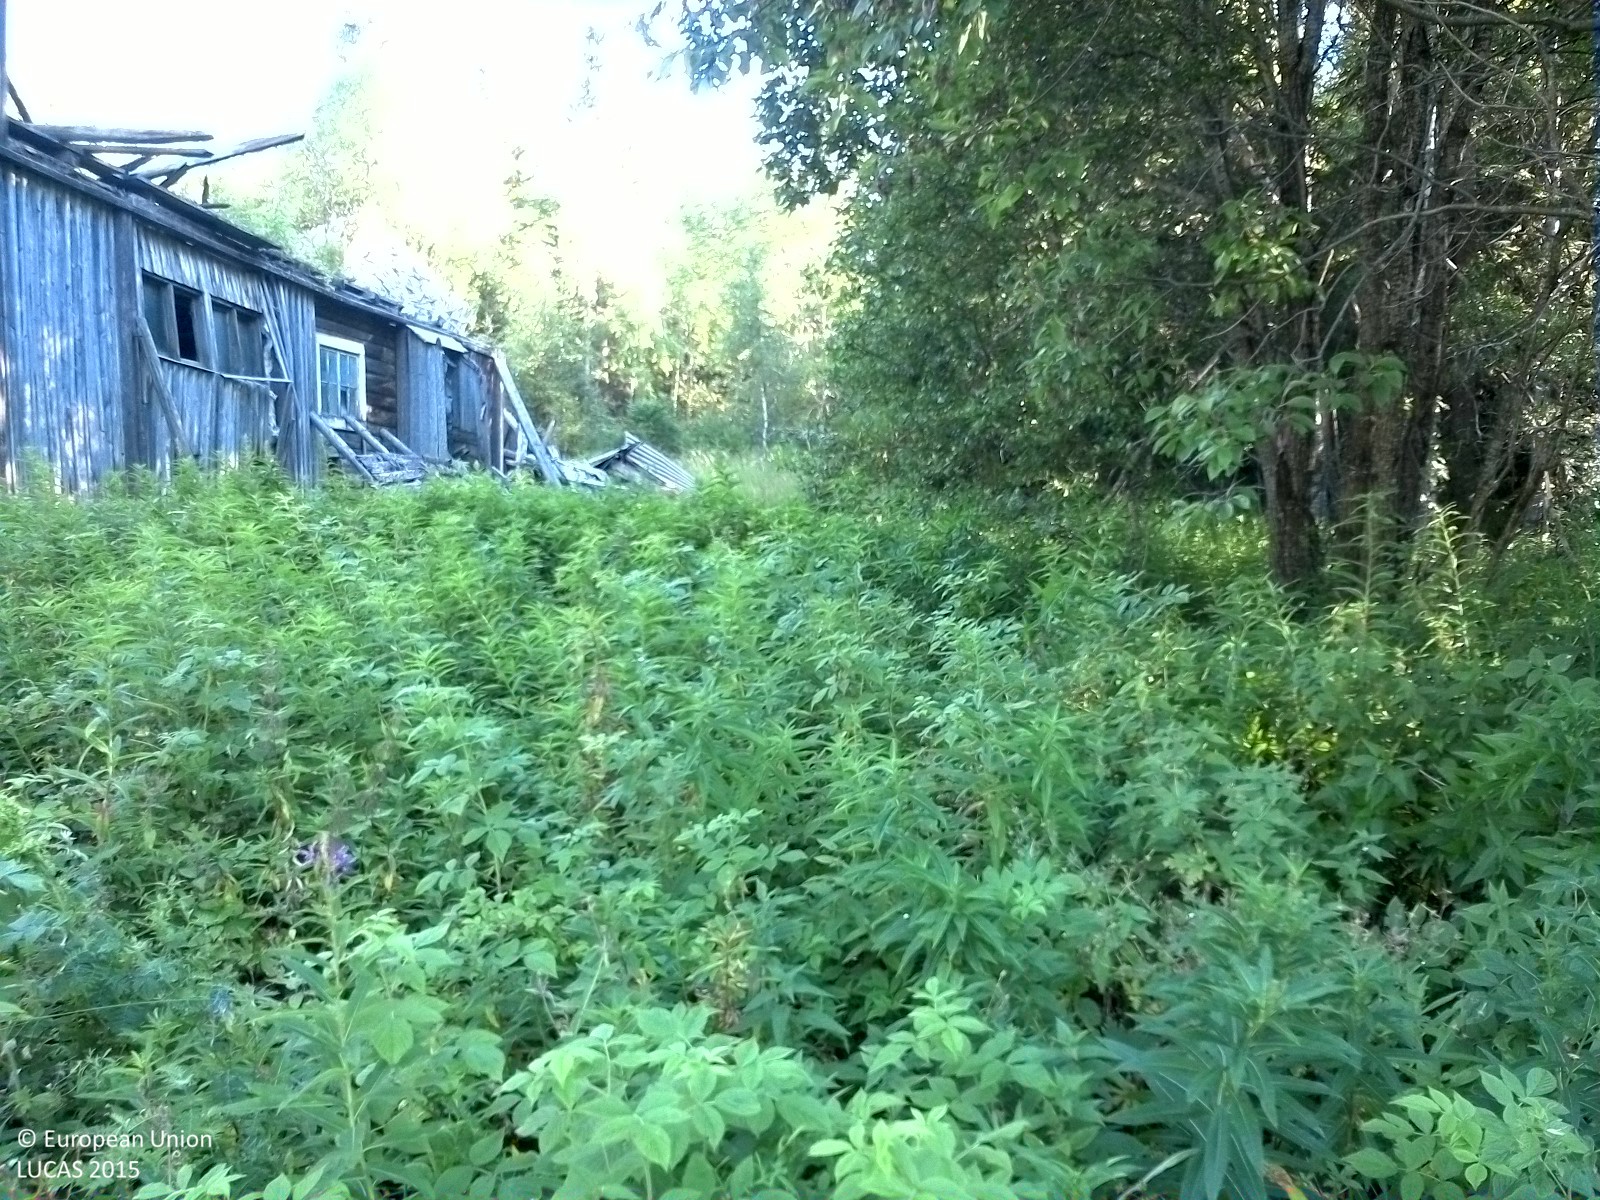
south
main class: Shrubland
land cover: Shrubland without tree cover
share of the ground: > 75 %
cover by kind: shrubs 50 %, herbaceous plants 50 %
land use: Residential
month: August
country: SE
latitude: 62.2578
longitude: 16.4314
